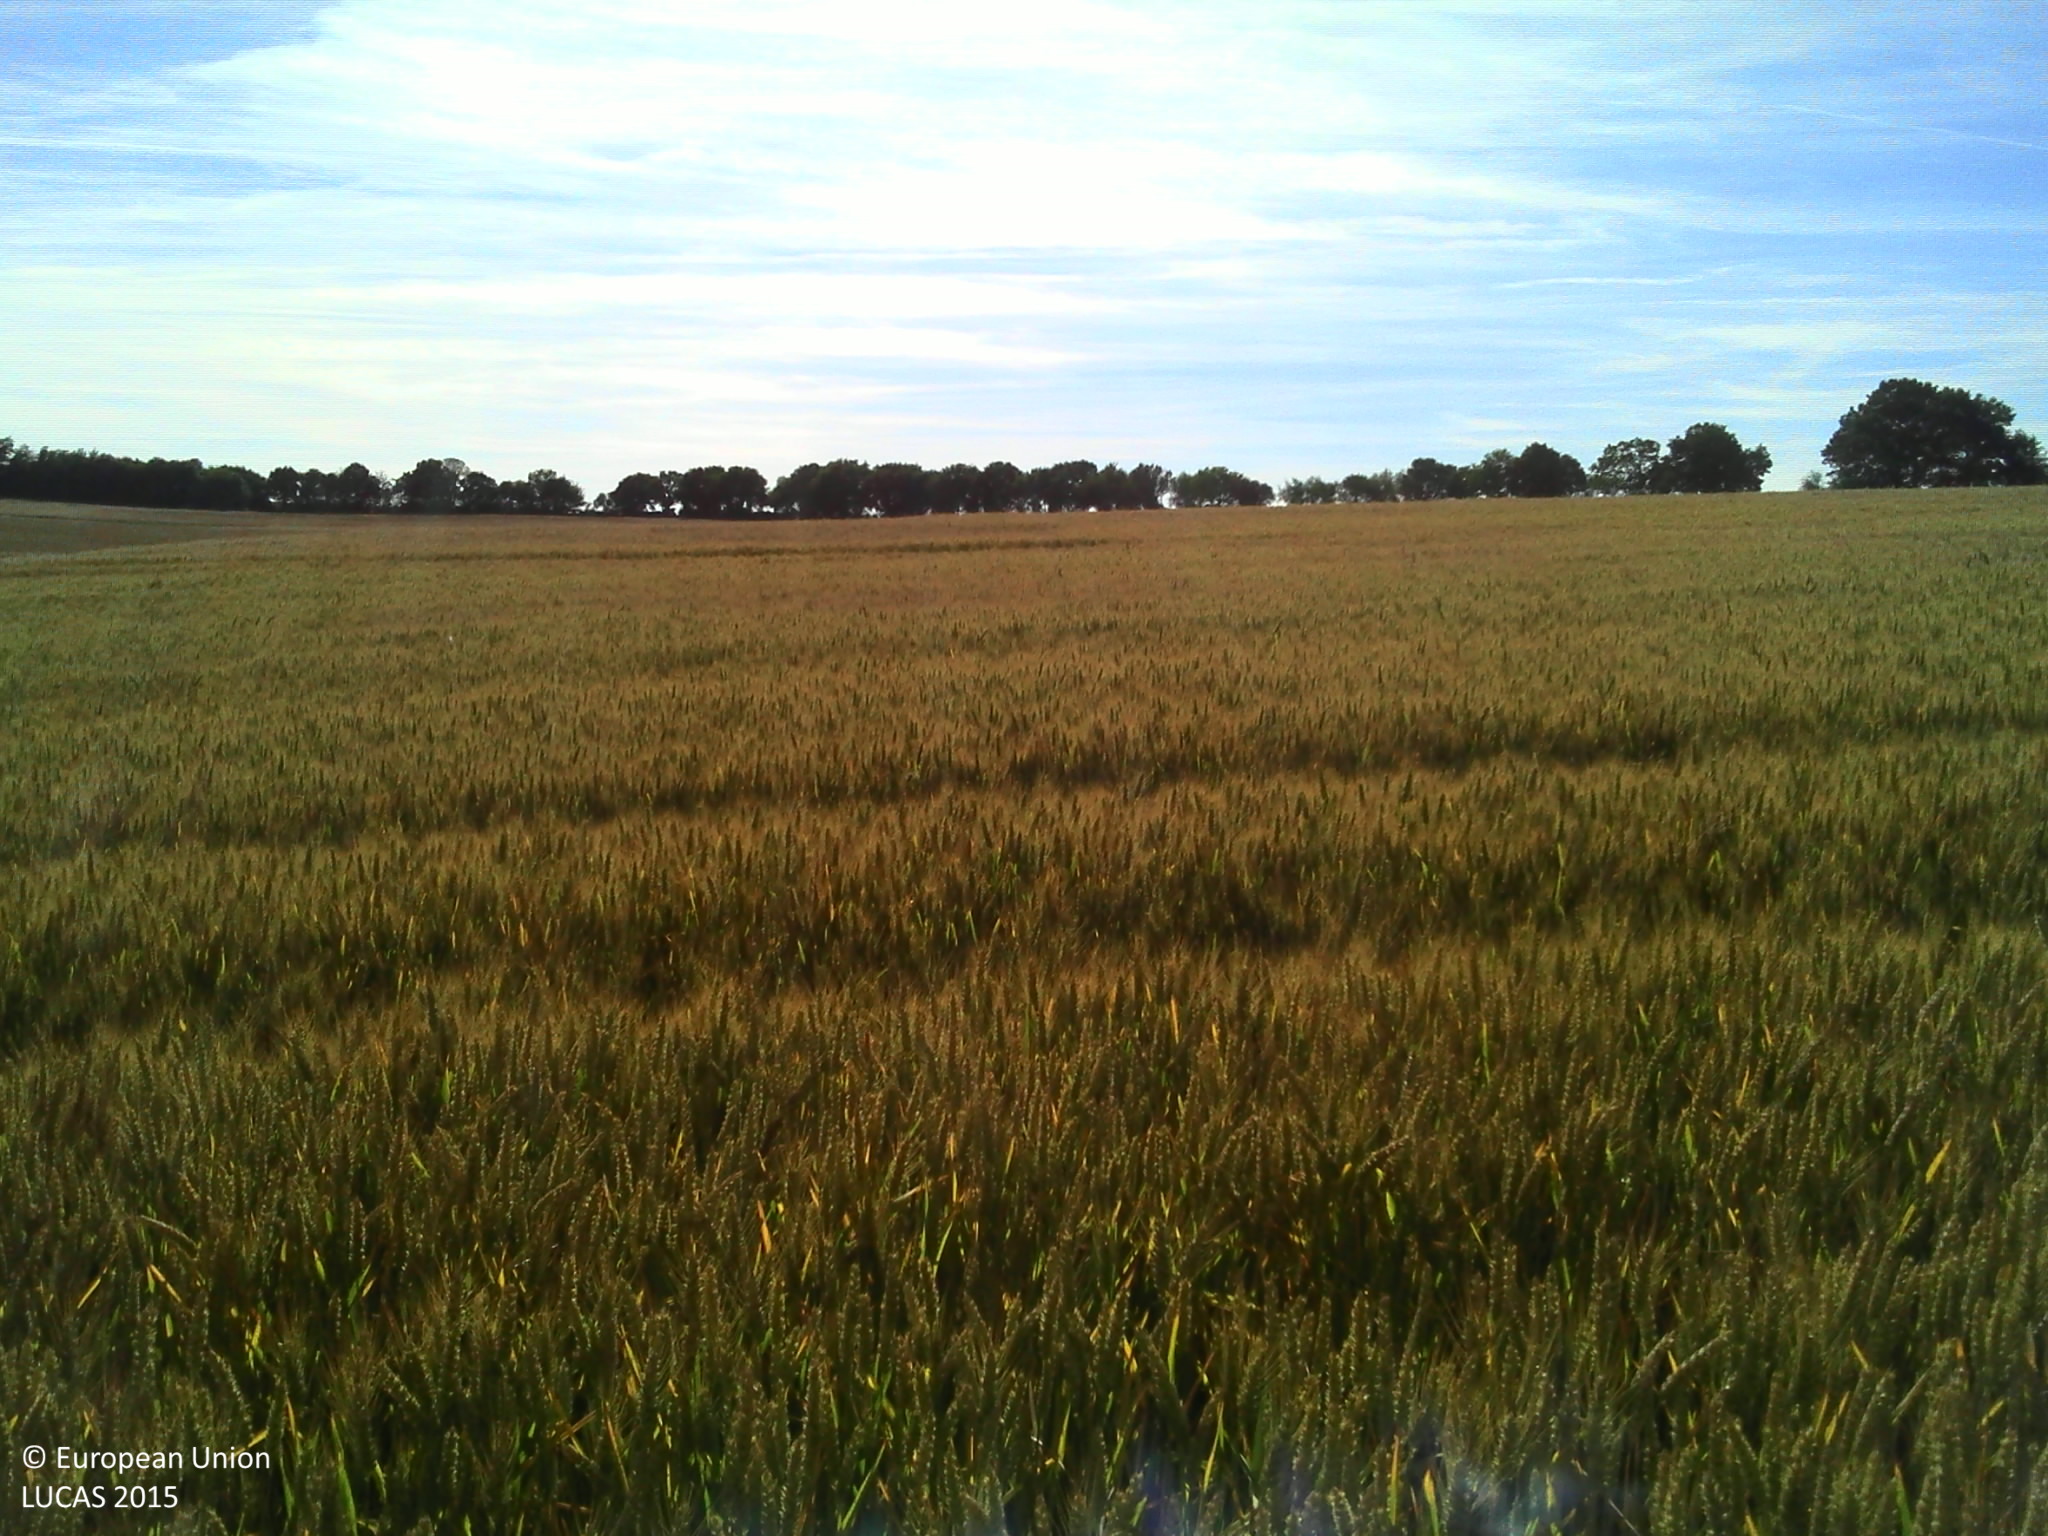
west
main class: Cropland
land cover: Common wheat
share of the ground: > 75 %
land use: Agriculture (excluding fallow land and kitchen gardens)
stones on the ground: 10 - 25 %
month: June
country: FR
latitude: 47.3992
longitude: 3.4907
